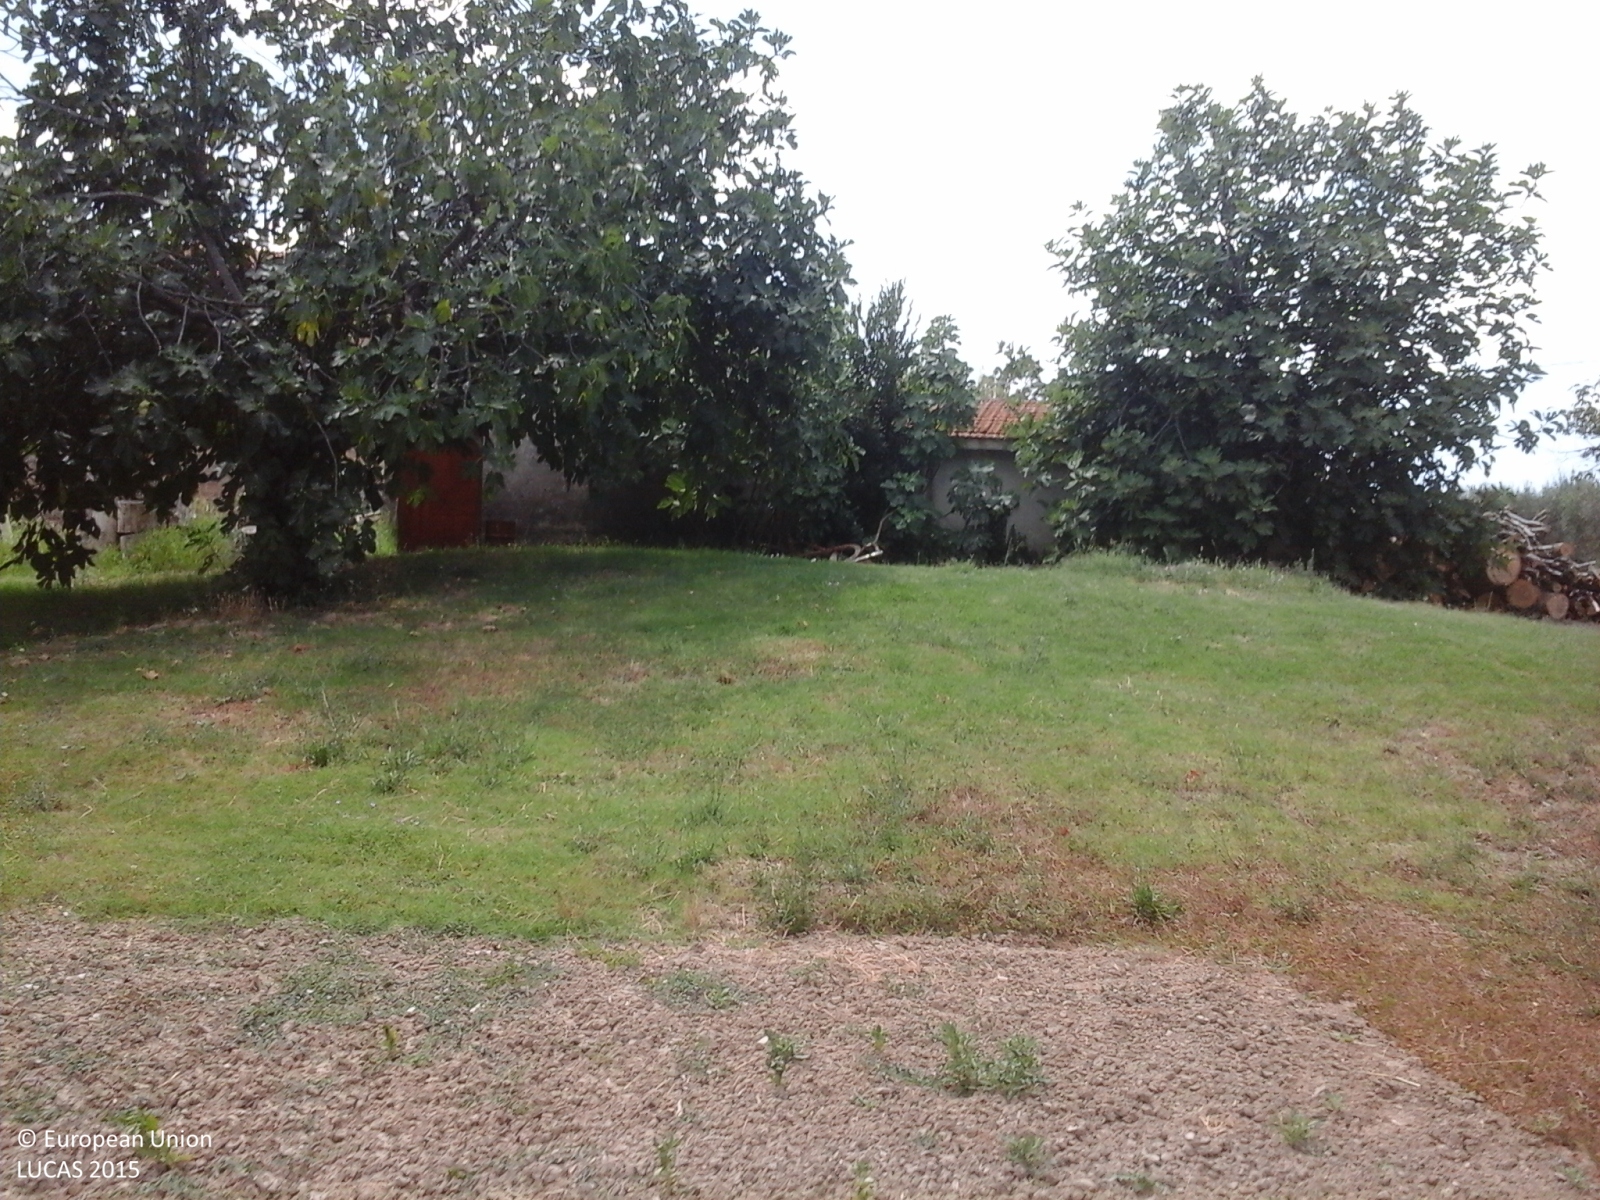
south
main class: Cropland
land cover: Olive groves
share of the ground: > 75 %
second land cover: Other bare soil
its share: > 75 %
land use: Agriculture (excluding fallow land and kitchen gardens)
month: July
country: IT
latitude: 43.3039
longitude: 13.3322
